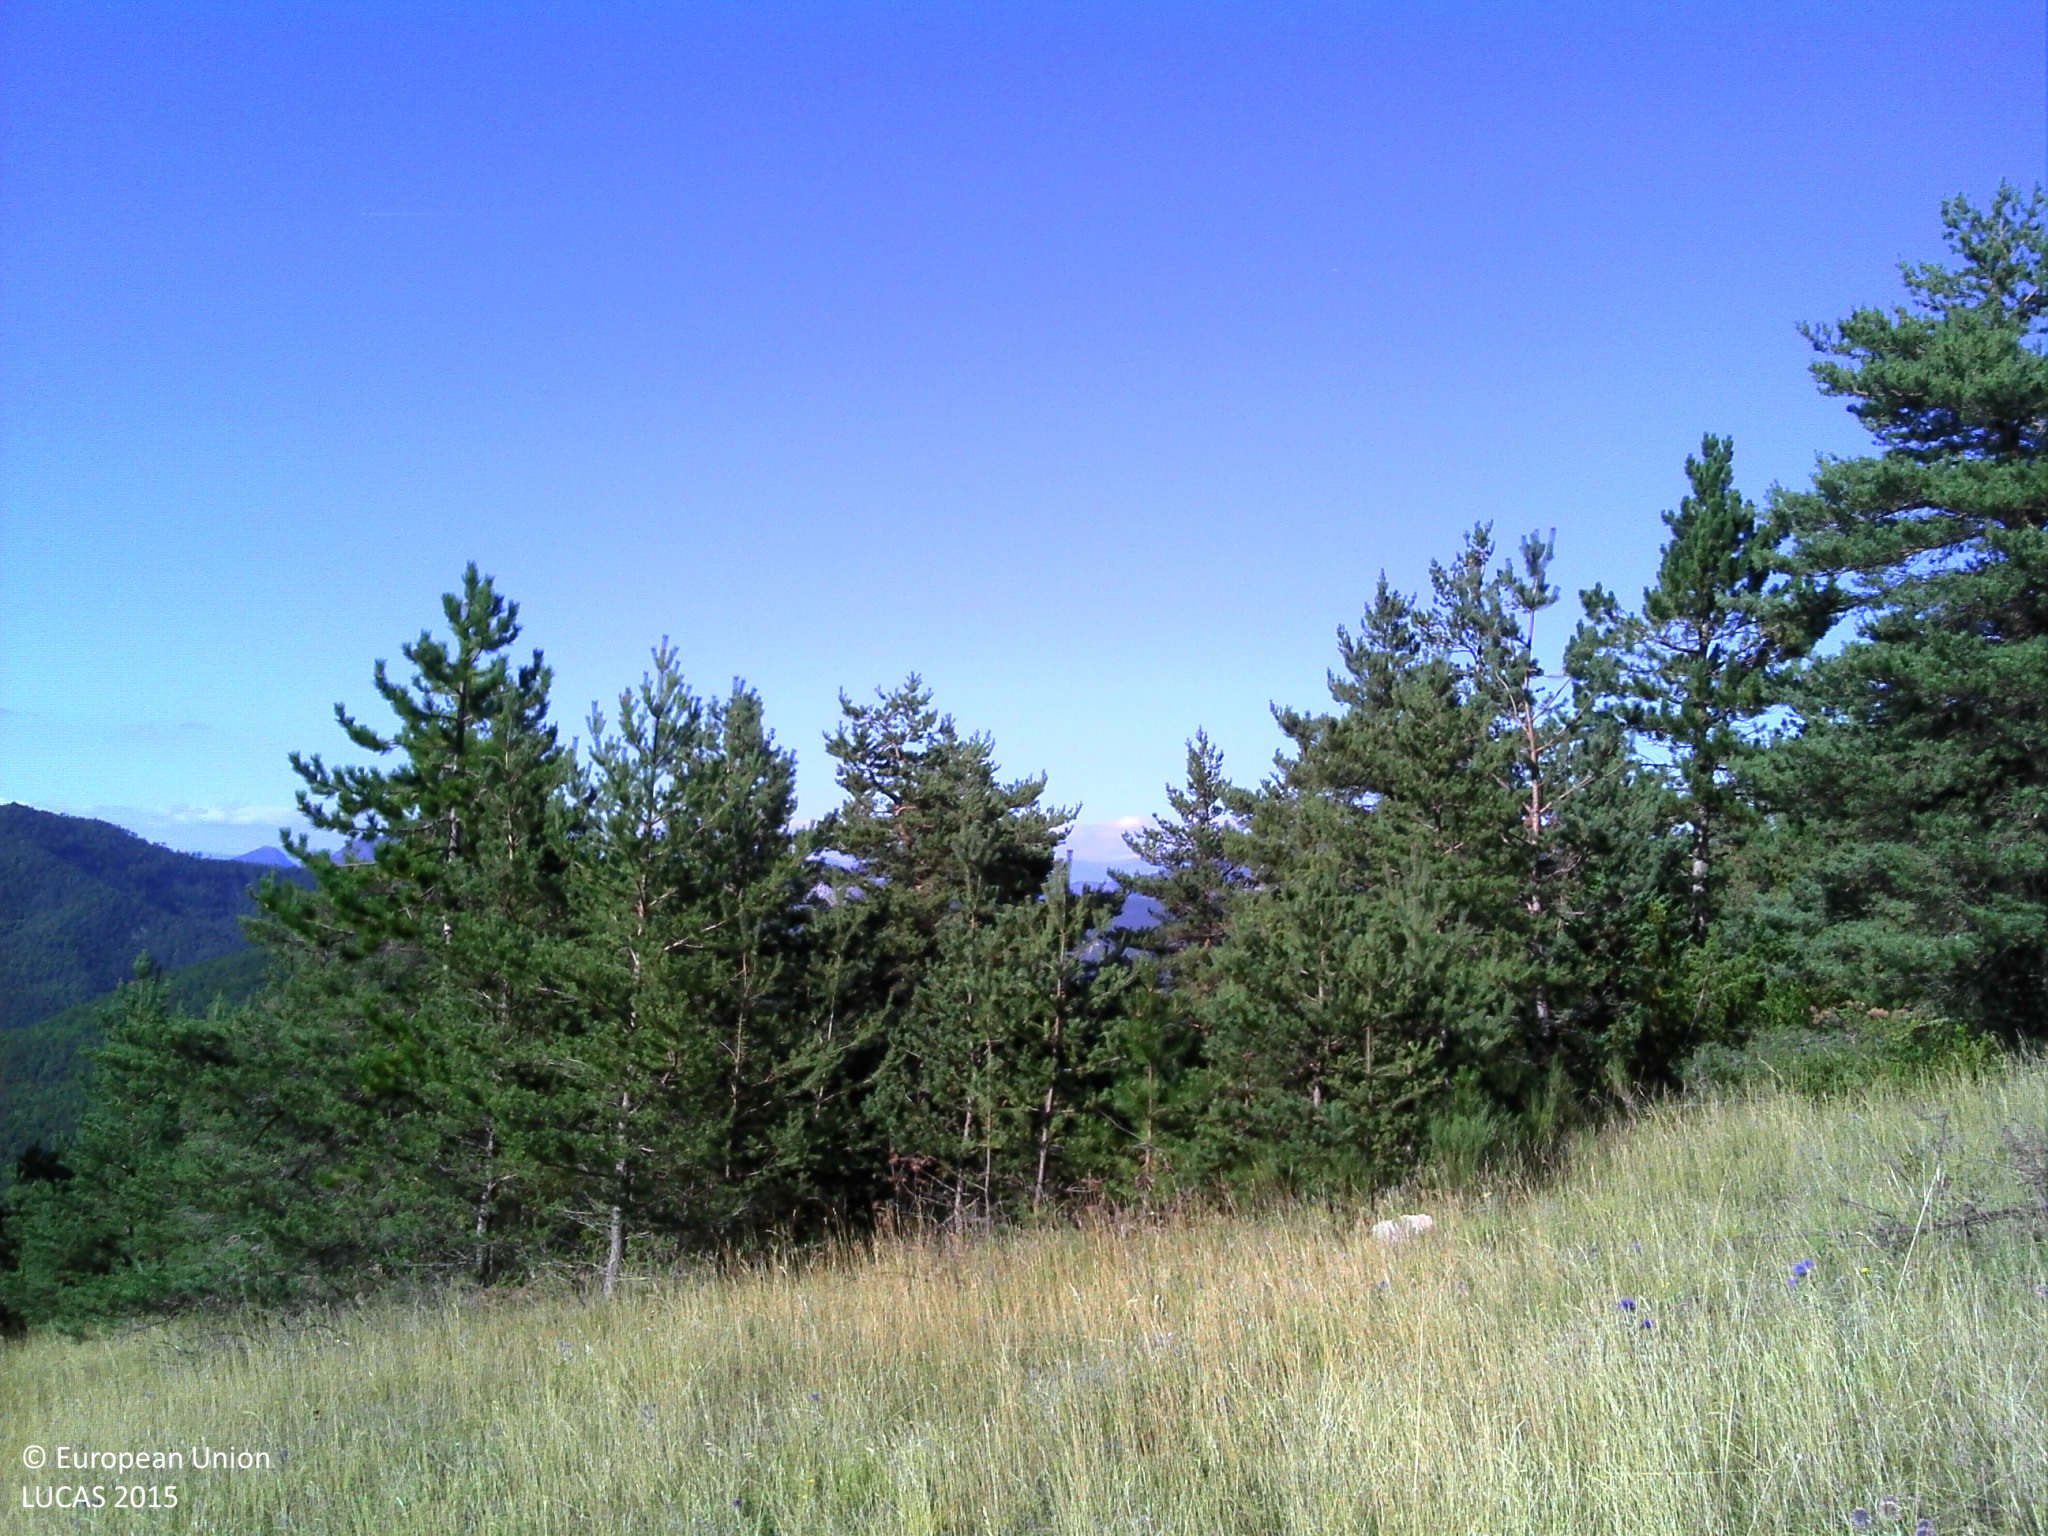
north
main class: Grassland
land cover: Grassland without tree/shrub cover
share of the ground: > 75 %
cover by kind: herbaceous plants 95 %, shrubs 5 %
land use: Agriculture (excluding fallow land and kitchen gardens)
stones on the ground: 25 - 50 %
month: September
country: FR
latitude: 44.4954
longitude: 5.2659
